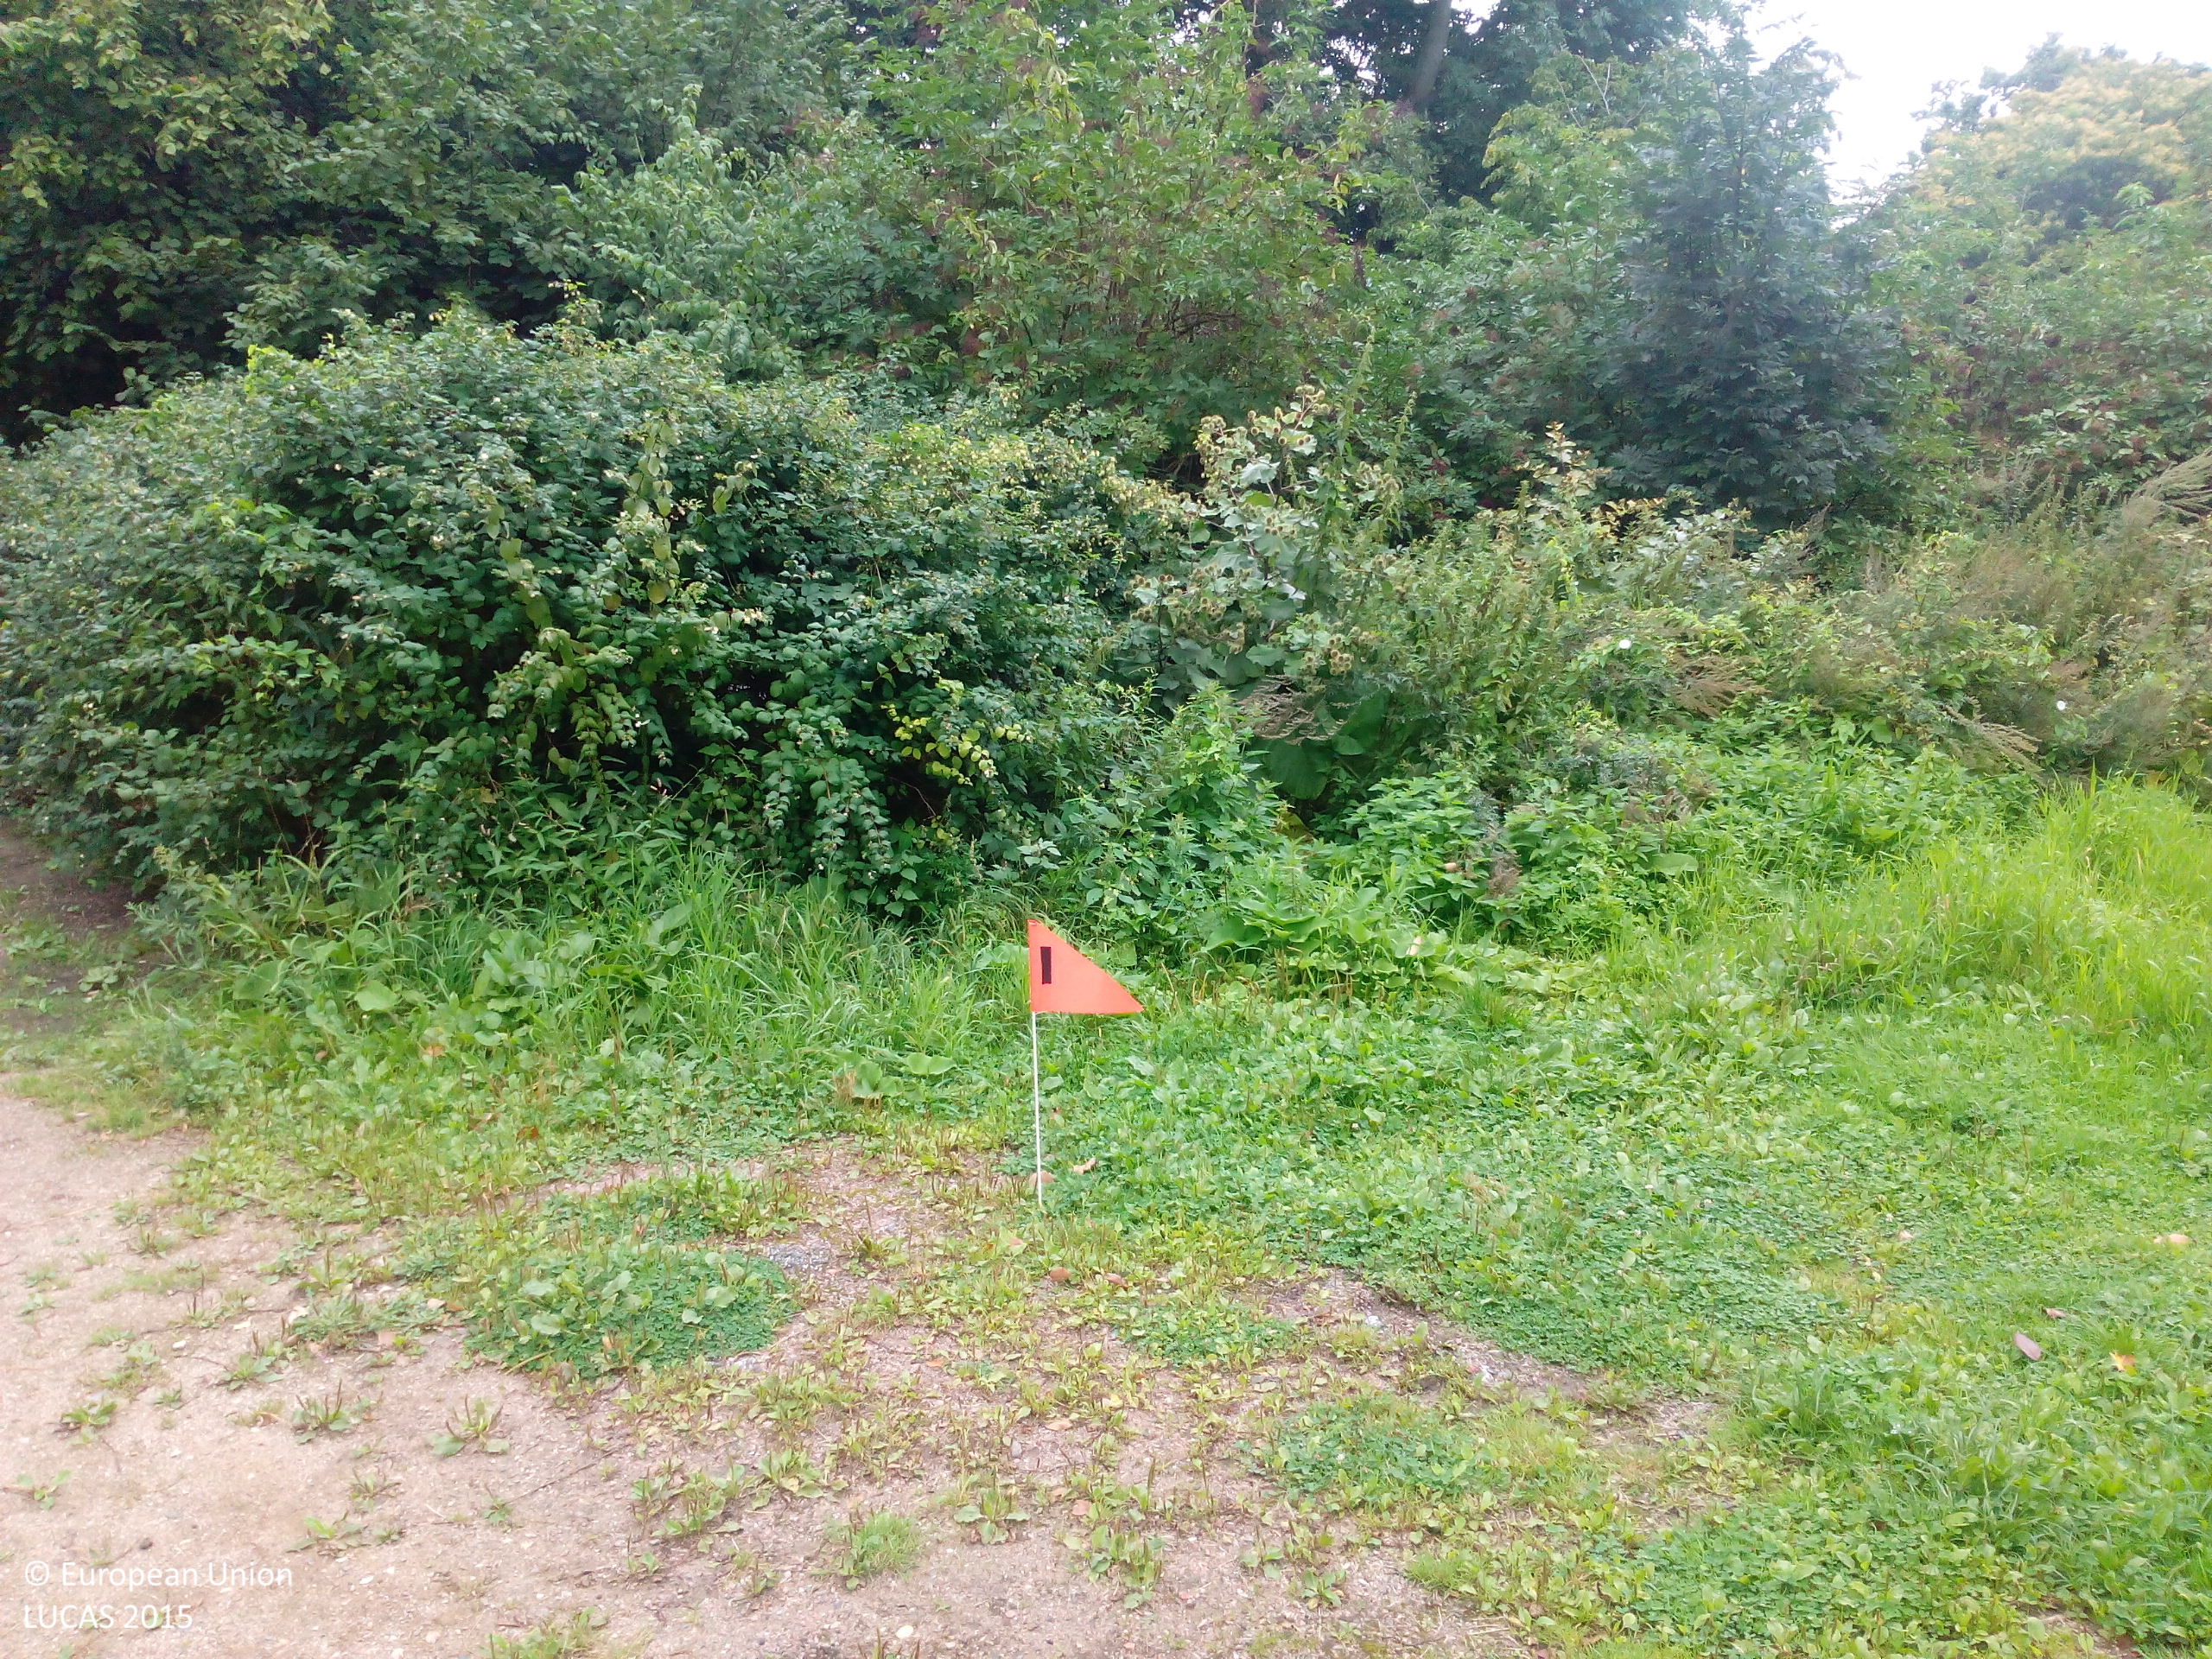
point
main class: Grassland
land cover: Spontaneously vegetated surfaces
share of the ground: > 75 %
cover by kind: herbaceous plants 95 %, shrubs 5 %
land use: Amenities, museums, leisure
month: August
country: DE
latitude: 53.5457
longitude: 9.9246
